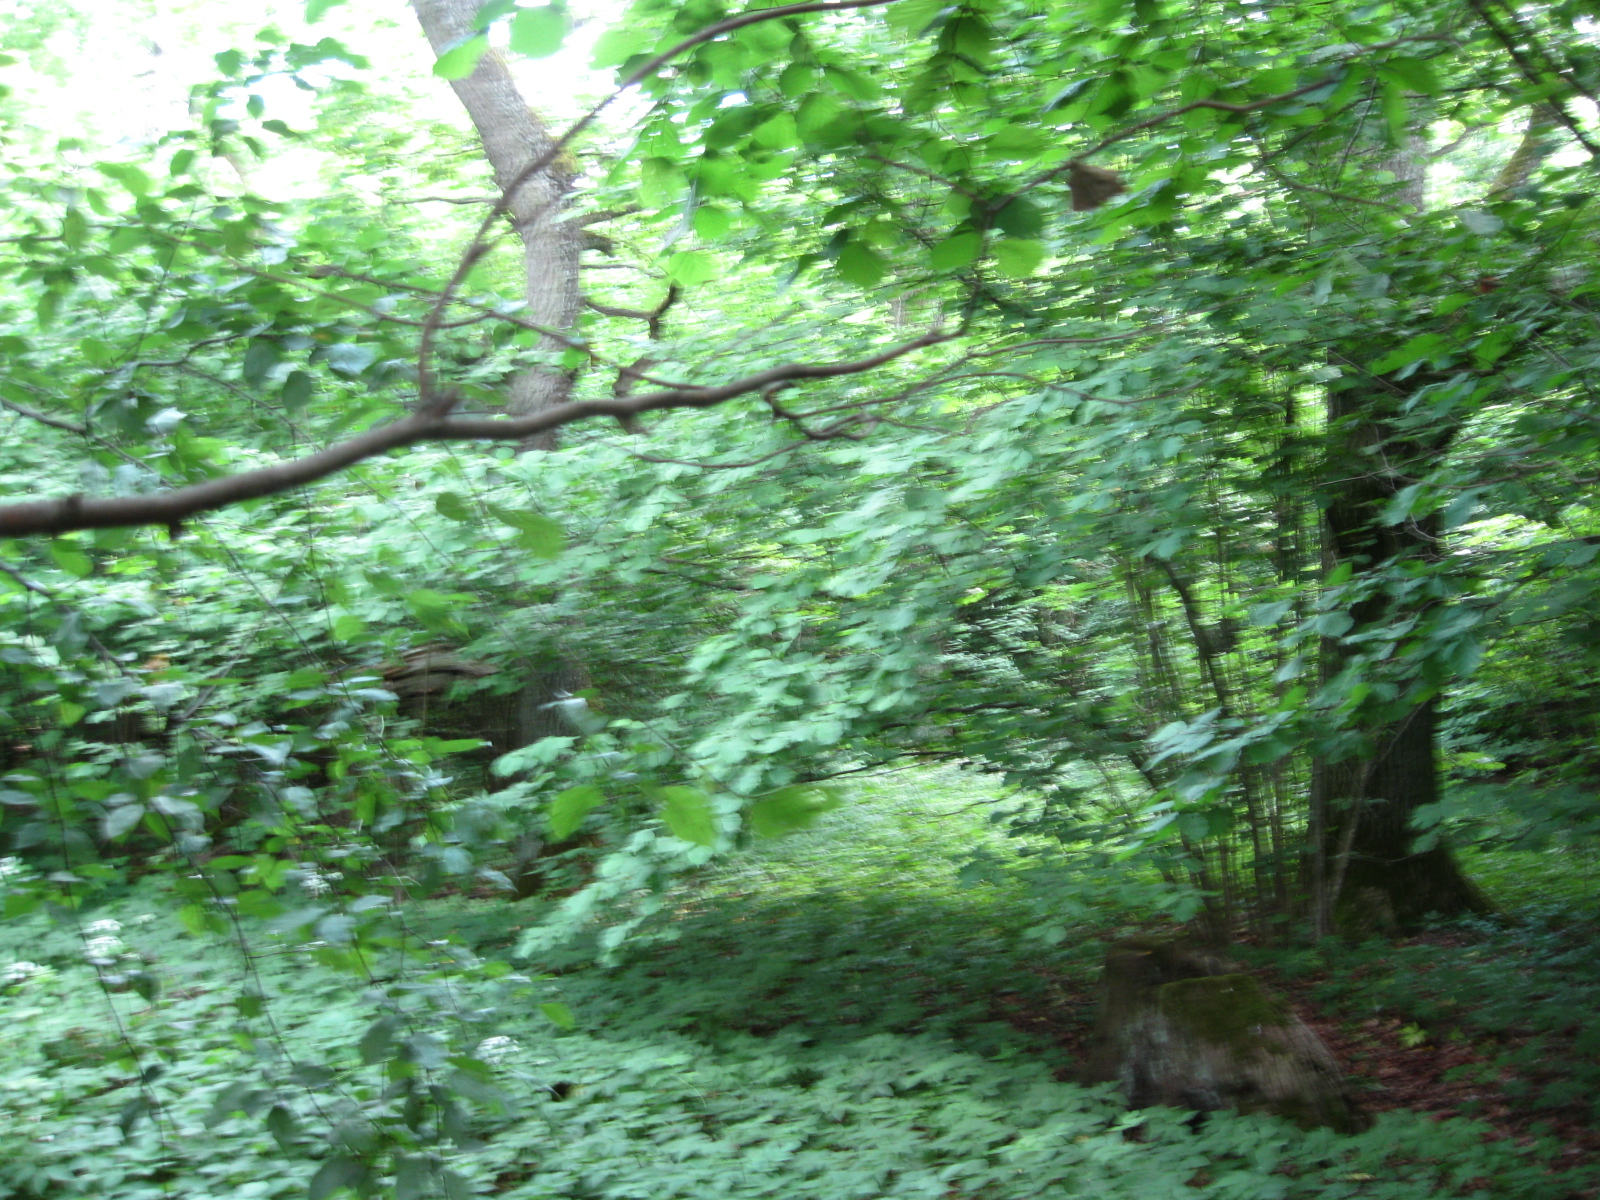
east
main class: Woodland
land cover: Broadleaved woodland
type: non-riverine alder, birch or aspen forest
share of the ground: > 75 %
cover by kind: broadleaved forest trees 90 %, shrubs 5 %, herbaceous plants 5 %
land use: Forestry
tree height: > 5 m
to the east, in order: Broadleaved woodland; Common wheat; Grassland without tree/shrub cover
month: June
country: LT
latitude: 55.4776
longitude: 24.0934
